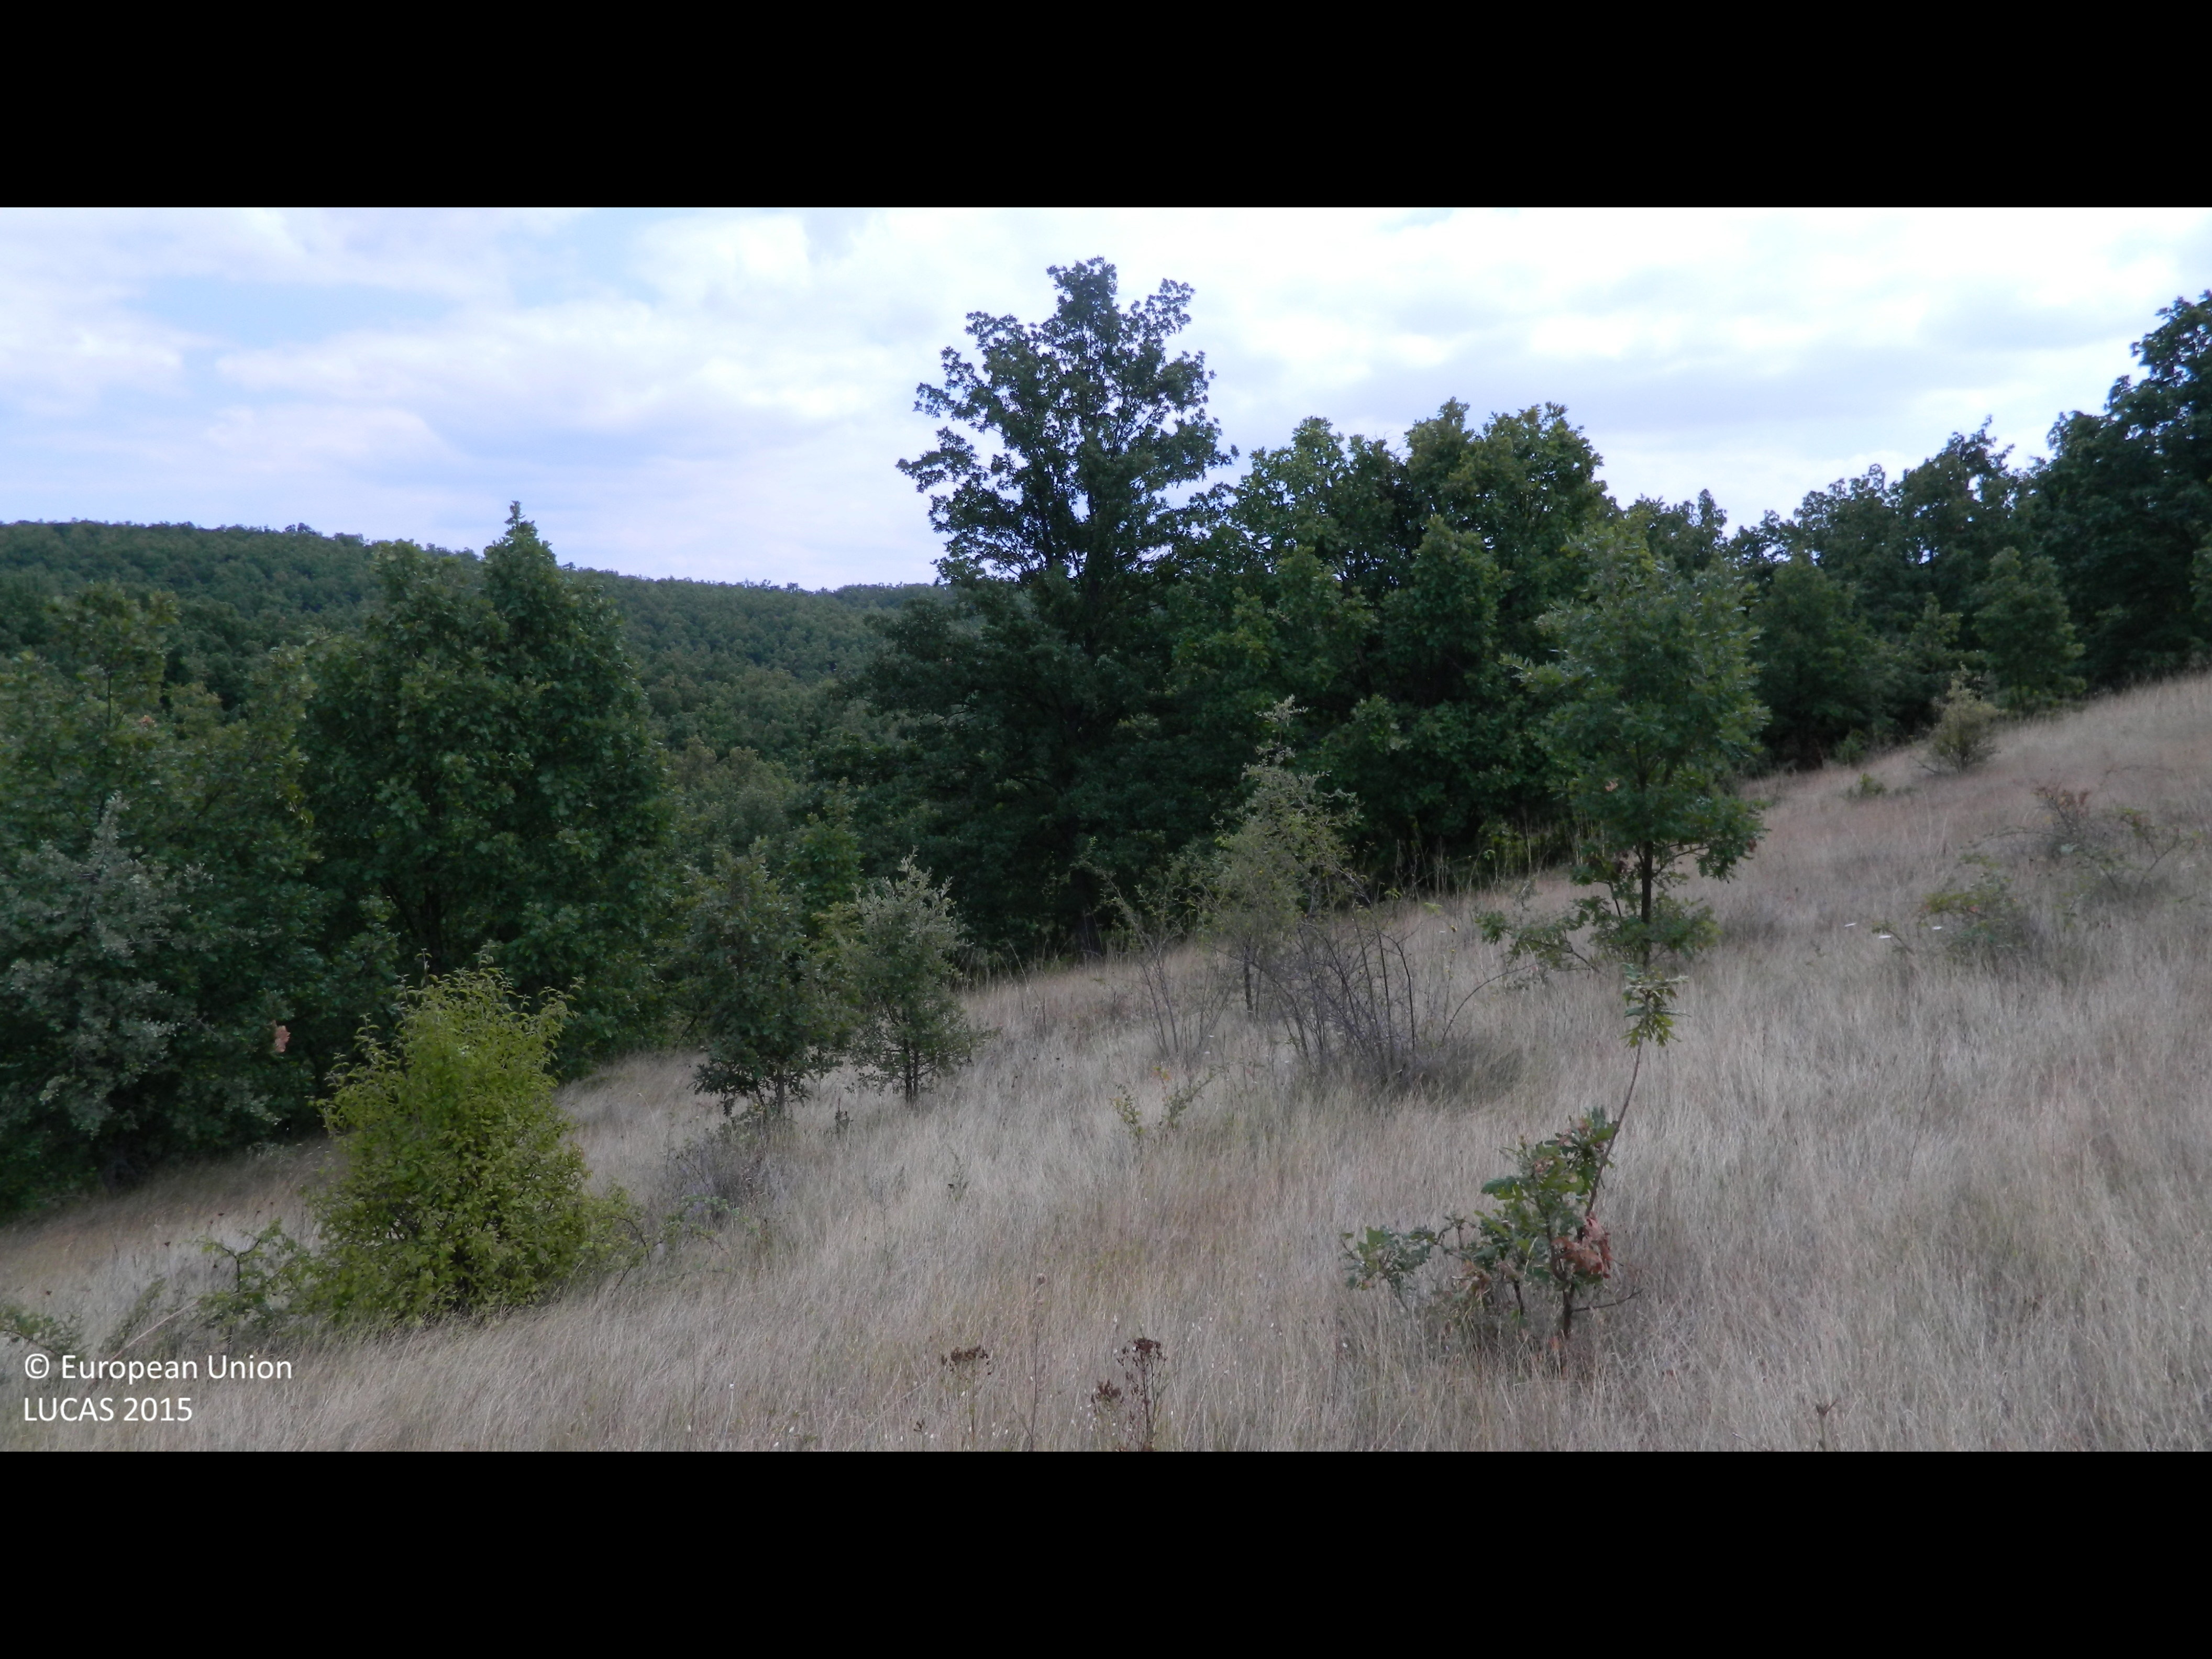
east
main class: Grassland
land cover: Grassland with sparse tree/shrub cover
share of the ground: > 75 %
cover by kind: herbaceous plants 85 %, shrubs 10 %, broadleaved forest trees 5 %
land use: Agriculture (excluding fallow land and kitchen gardens)
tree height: < 5 m
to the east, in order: Grassland with sparse tree/shrub cover; Broadleaved woodland; Rivers and streams; Broadleaved woodland; Rivers and streams; Broadleaved woodland
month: August
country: BG
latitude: 41.7095
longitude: 25.8474
